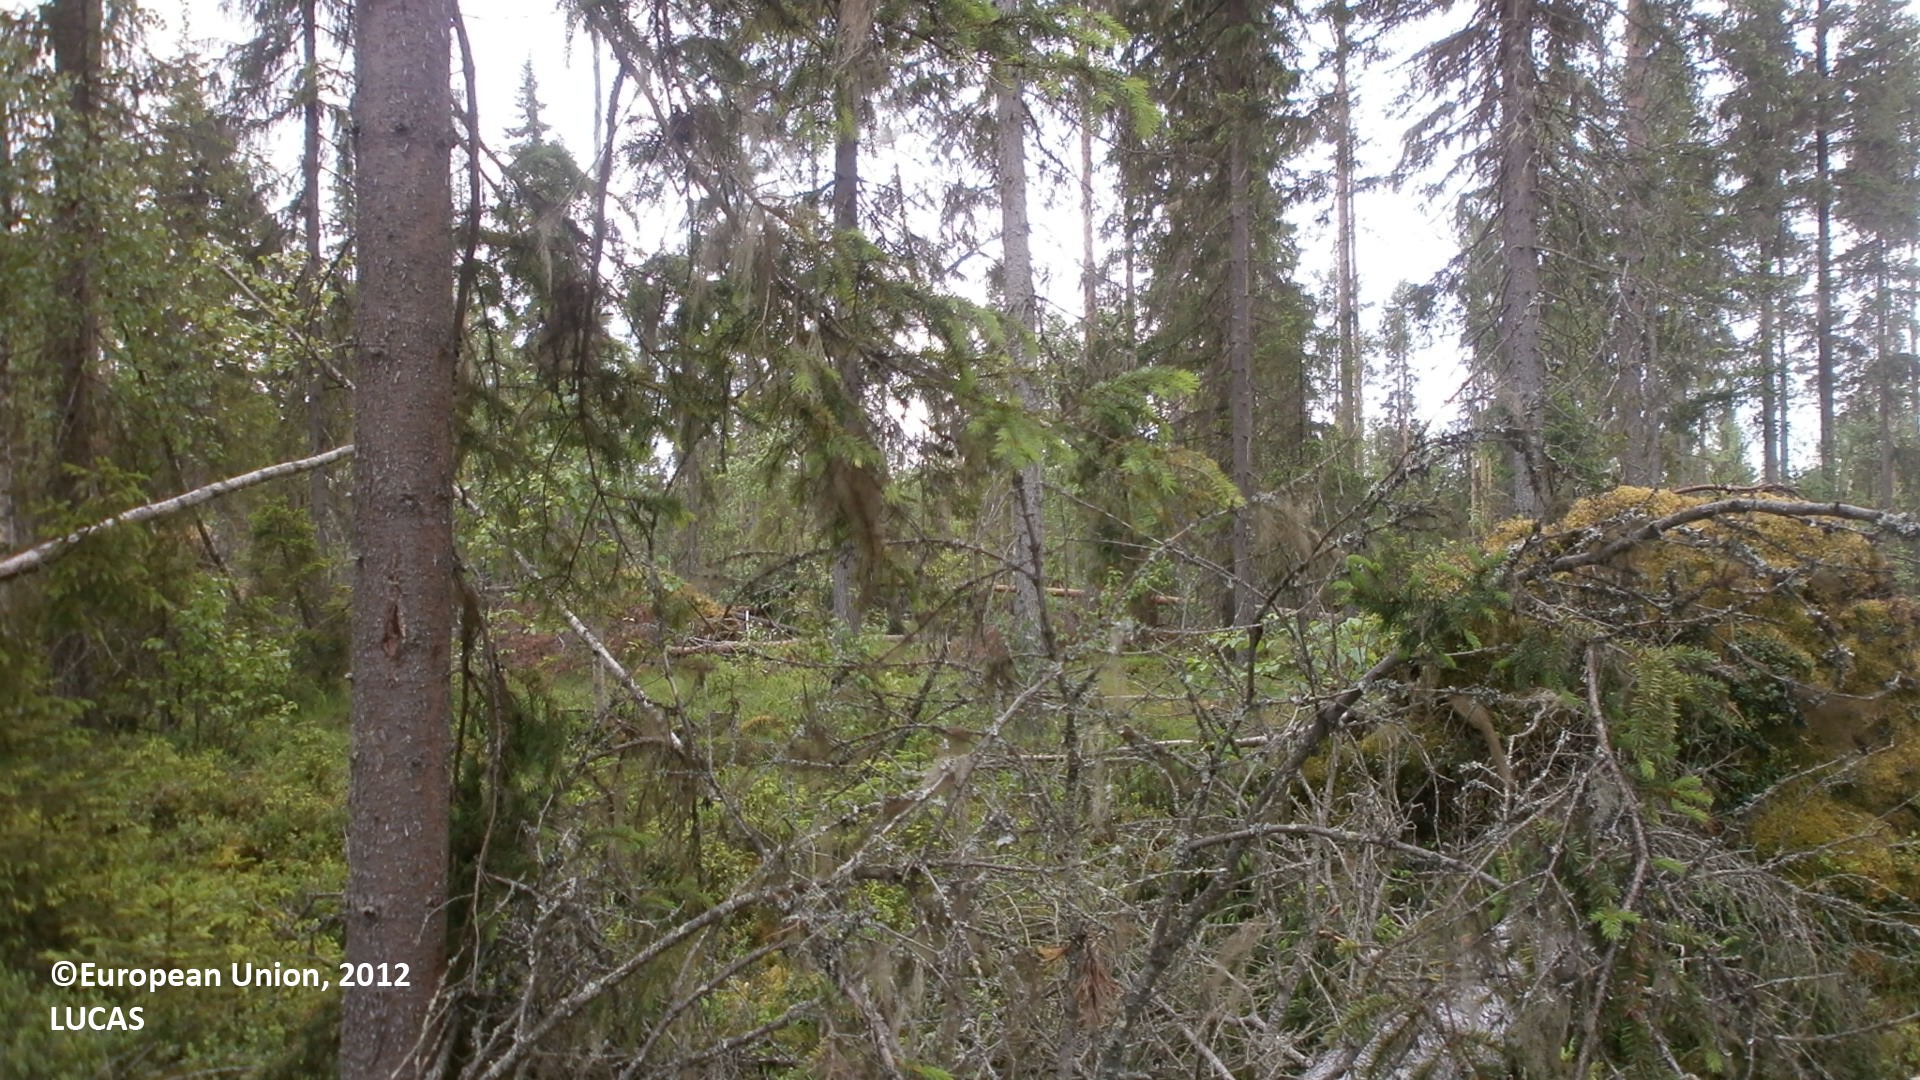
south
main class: Woodland
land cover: Other coniferous woodland
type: boreal forest
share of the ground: 50 - 75 %
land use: Forestry
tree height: > 5 m
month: June
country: FI
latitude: 64.2119
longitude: 25.7779
